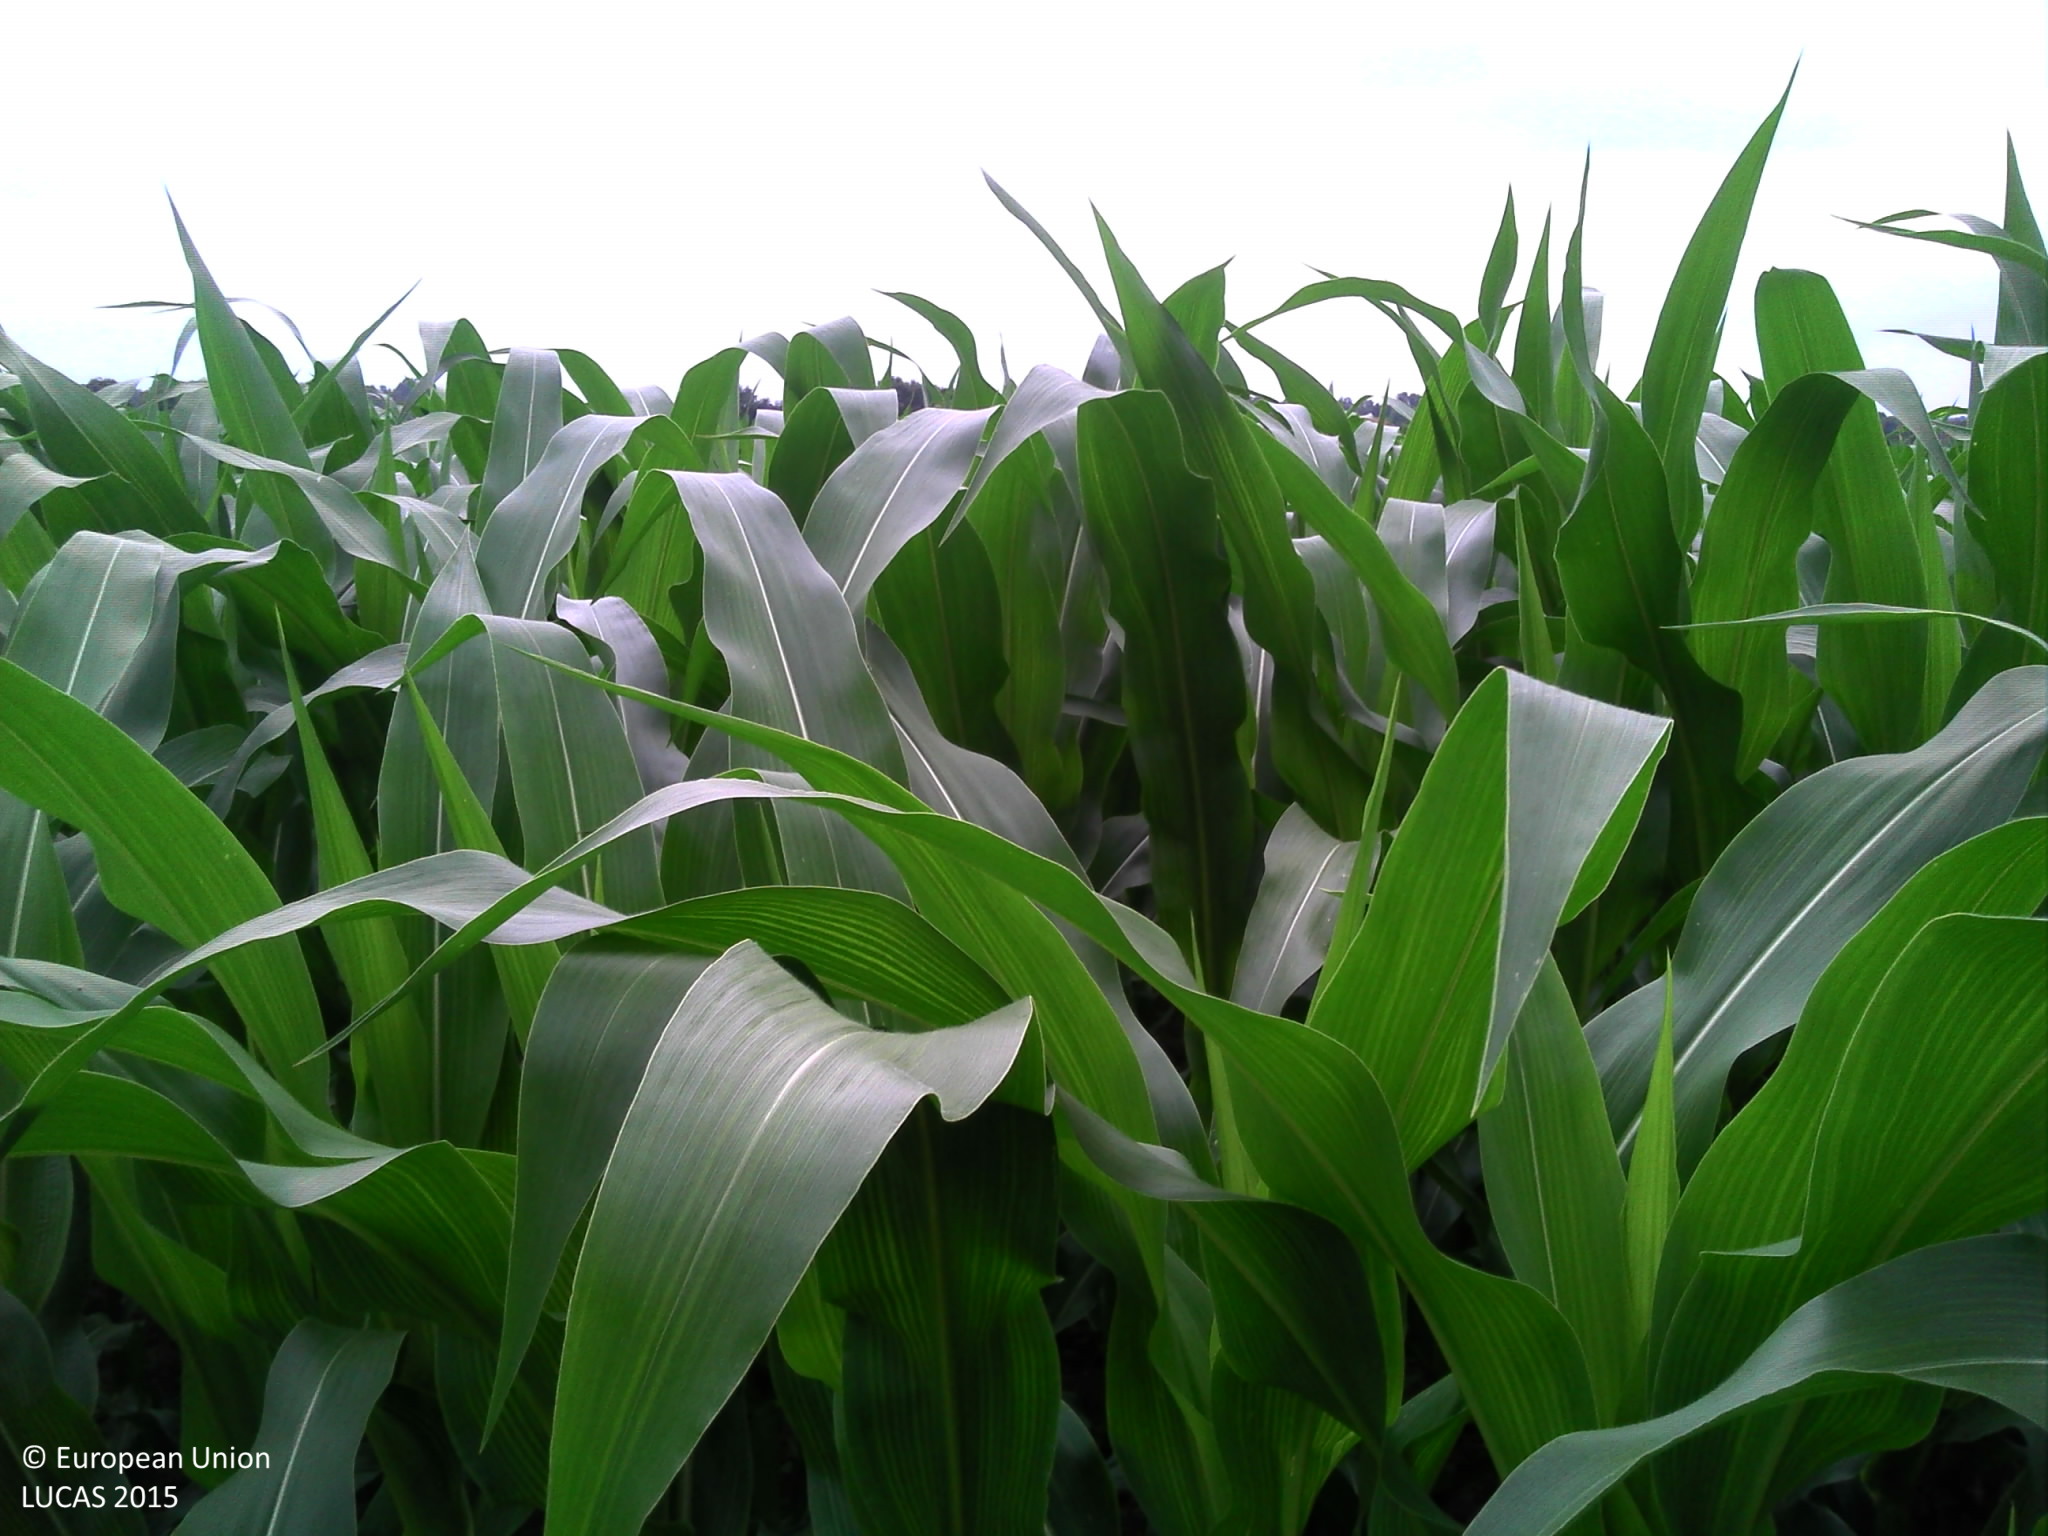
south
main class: Cropland
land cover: Maize
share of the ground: > 75 %
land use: Agriculture (excluding fallow land and kitchen gardens)
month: July
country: FR
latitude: 43.5878
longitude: -0.7752
